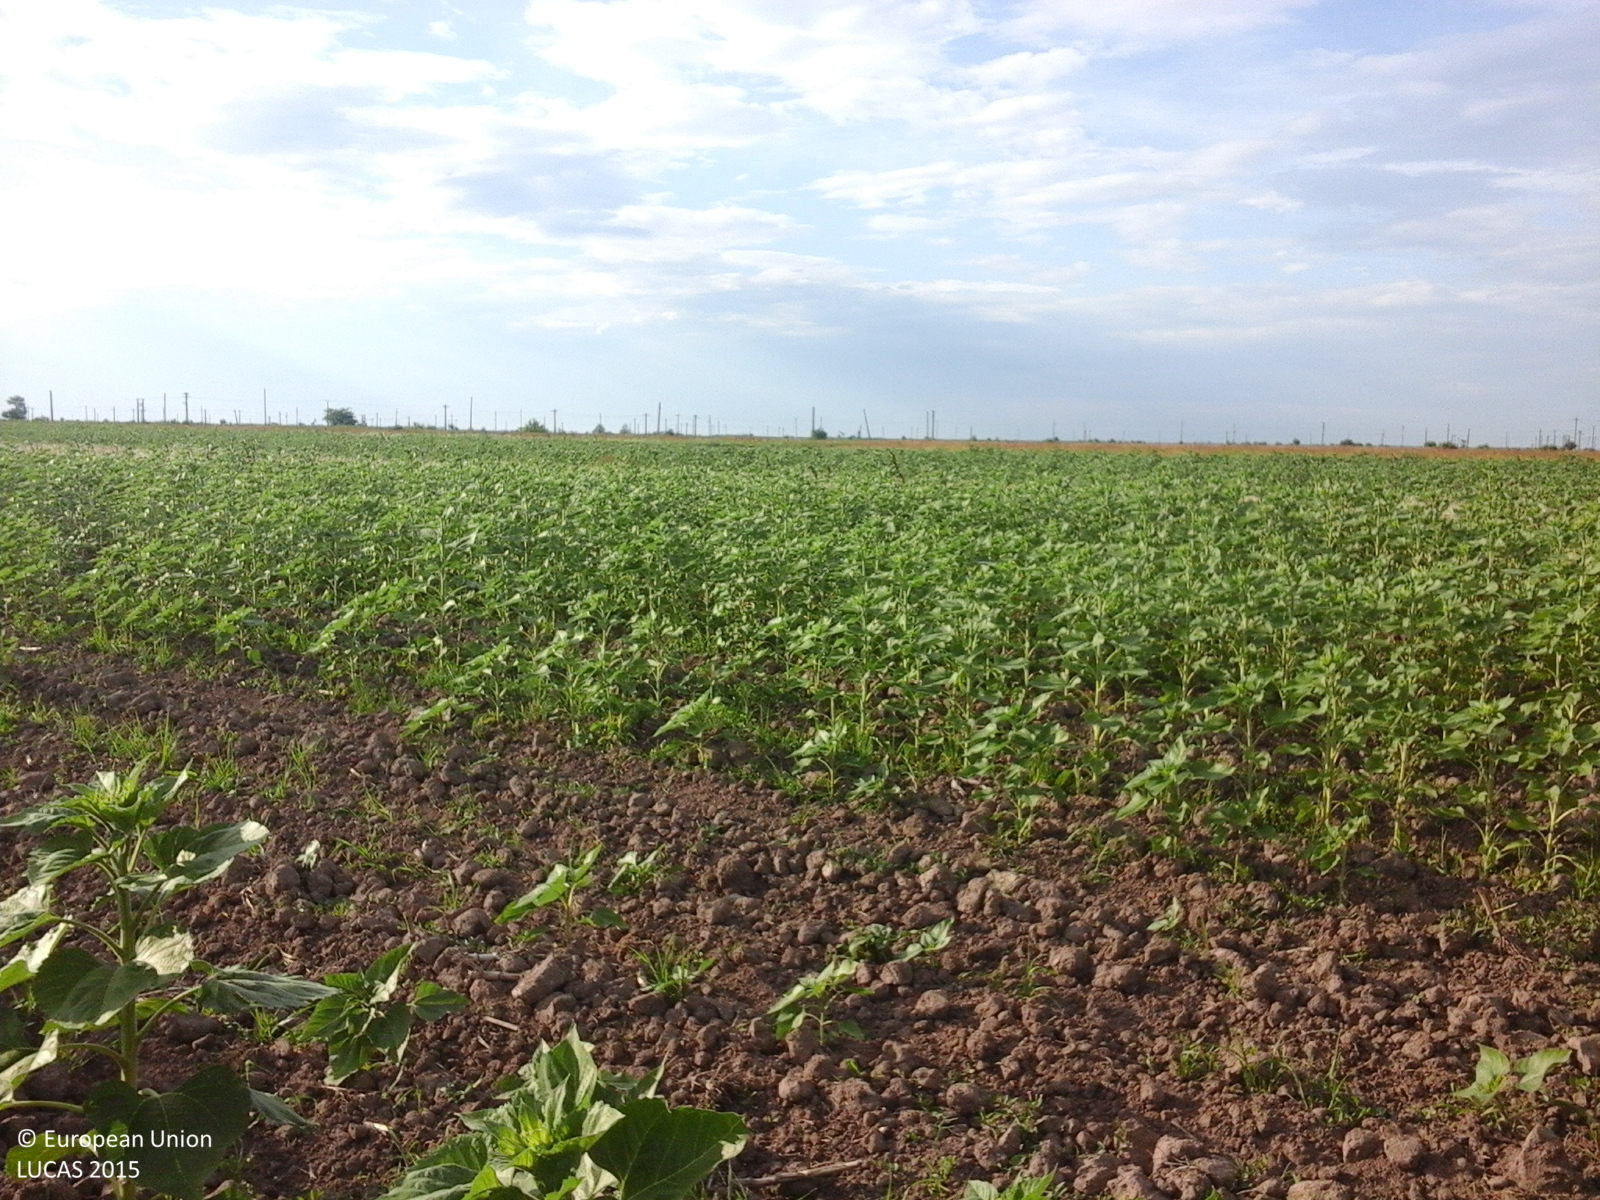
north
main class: Cropland
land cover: Sunflower
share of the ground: 50 - 75 %
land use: Agriculture (excluding fallow land and kitchen gardens)
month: July
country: RO
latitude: 44.3999
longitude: 25.4193
